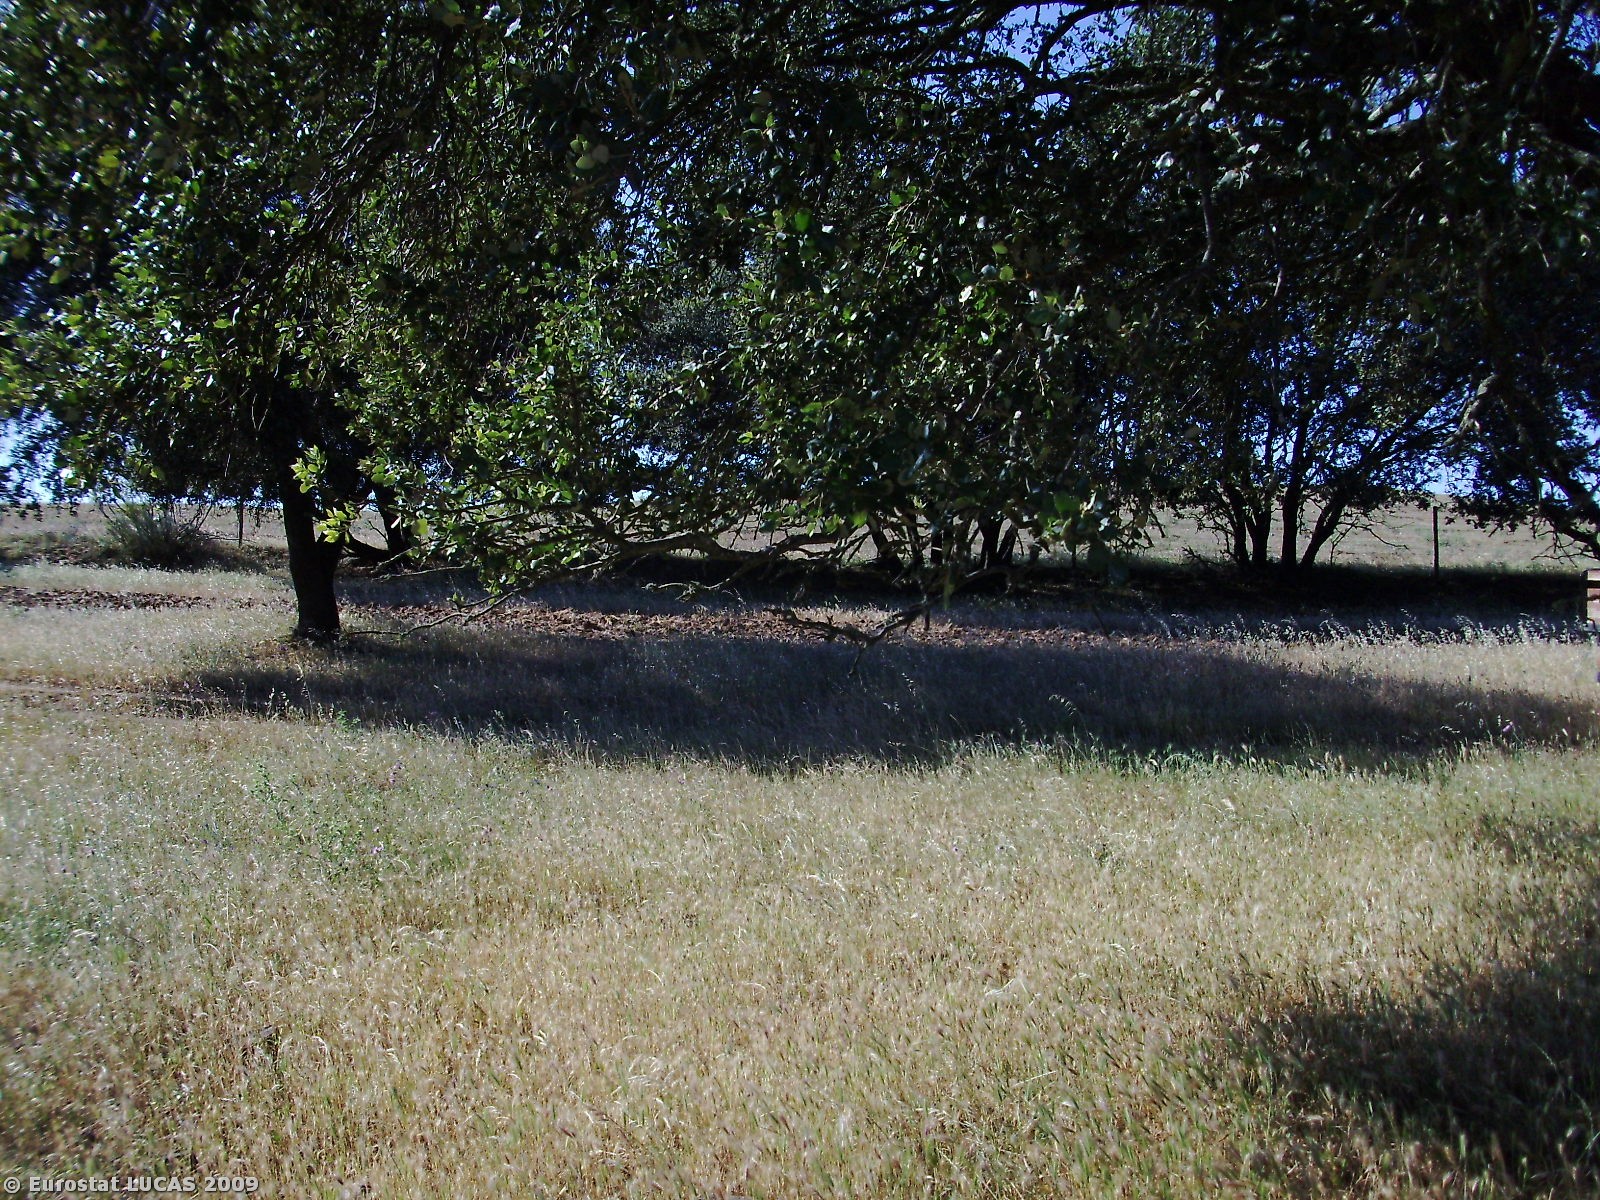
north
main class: Woodland
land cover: Broadleaved woodland
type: broadleaved evergreen forest
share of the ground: 10 - 25 %
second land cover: Grassland with sparse tree/shrub cover
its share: 50 - 75 %
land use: Forestry
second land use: Agriculture (excluding fallow land and kitchen gardens)
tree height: > 5 m
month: May
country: PT
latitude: 38.9612
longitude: -7.3795
